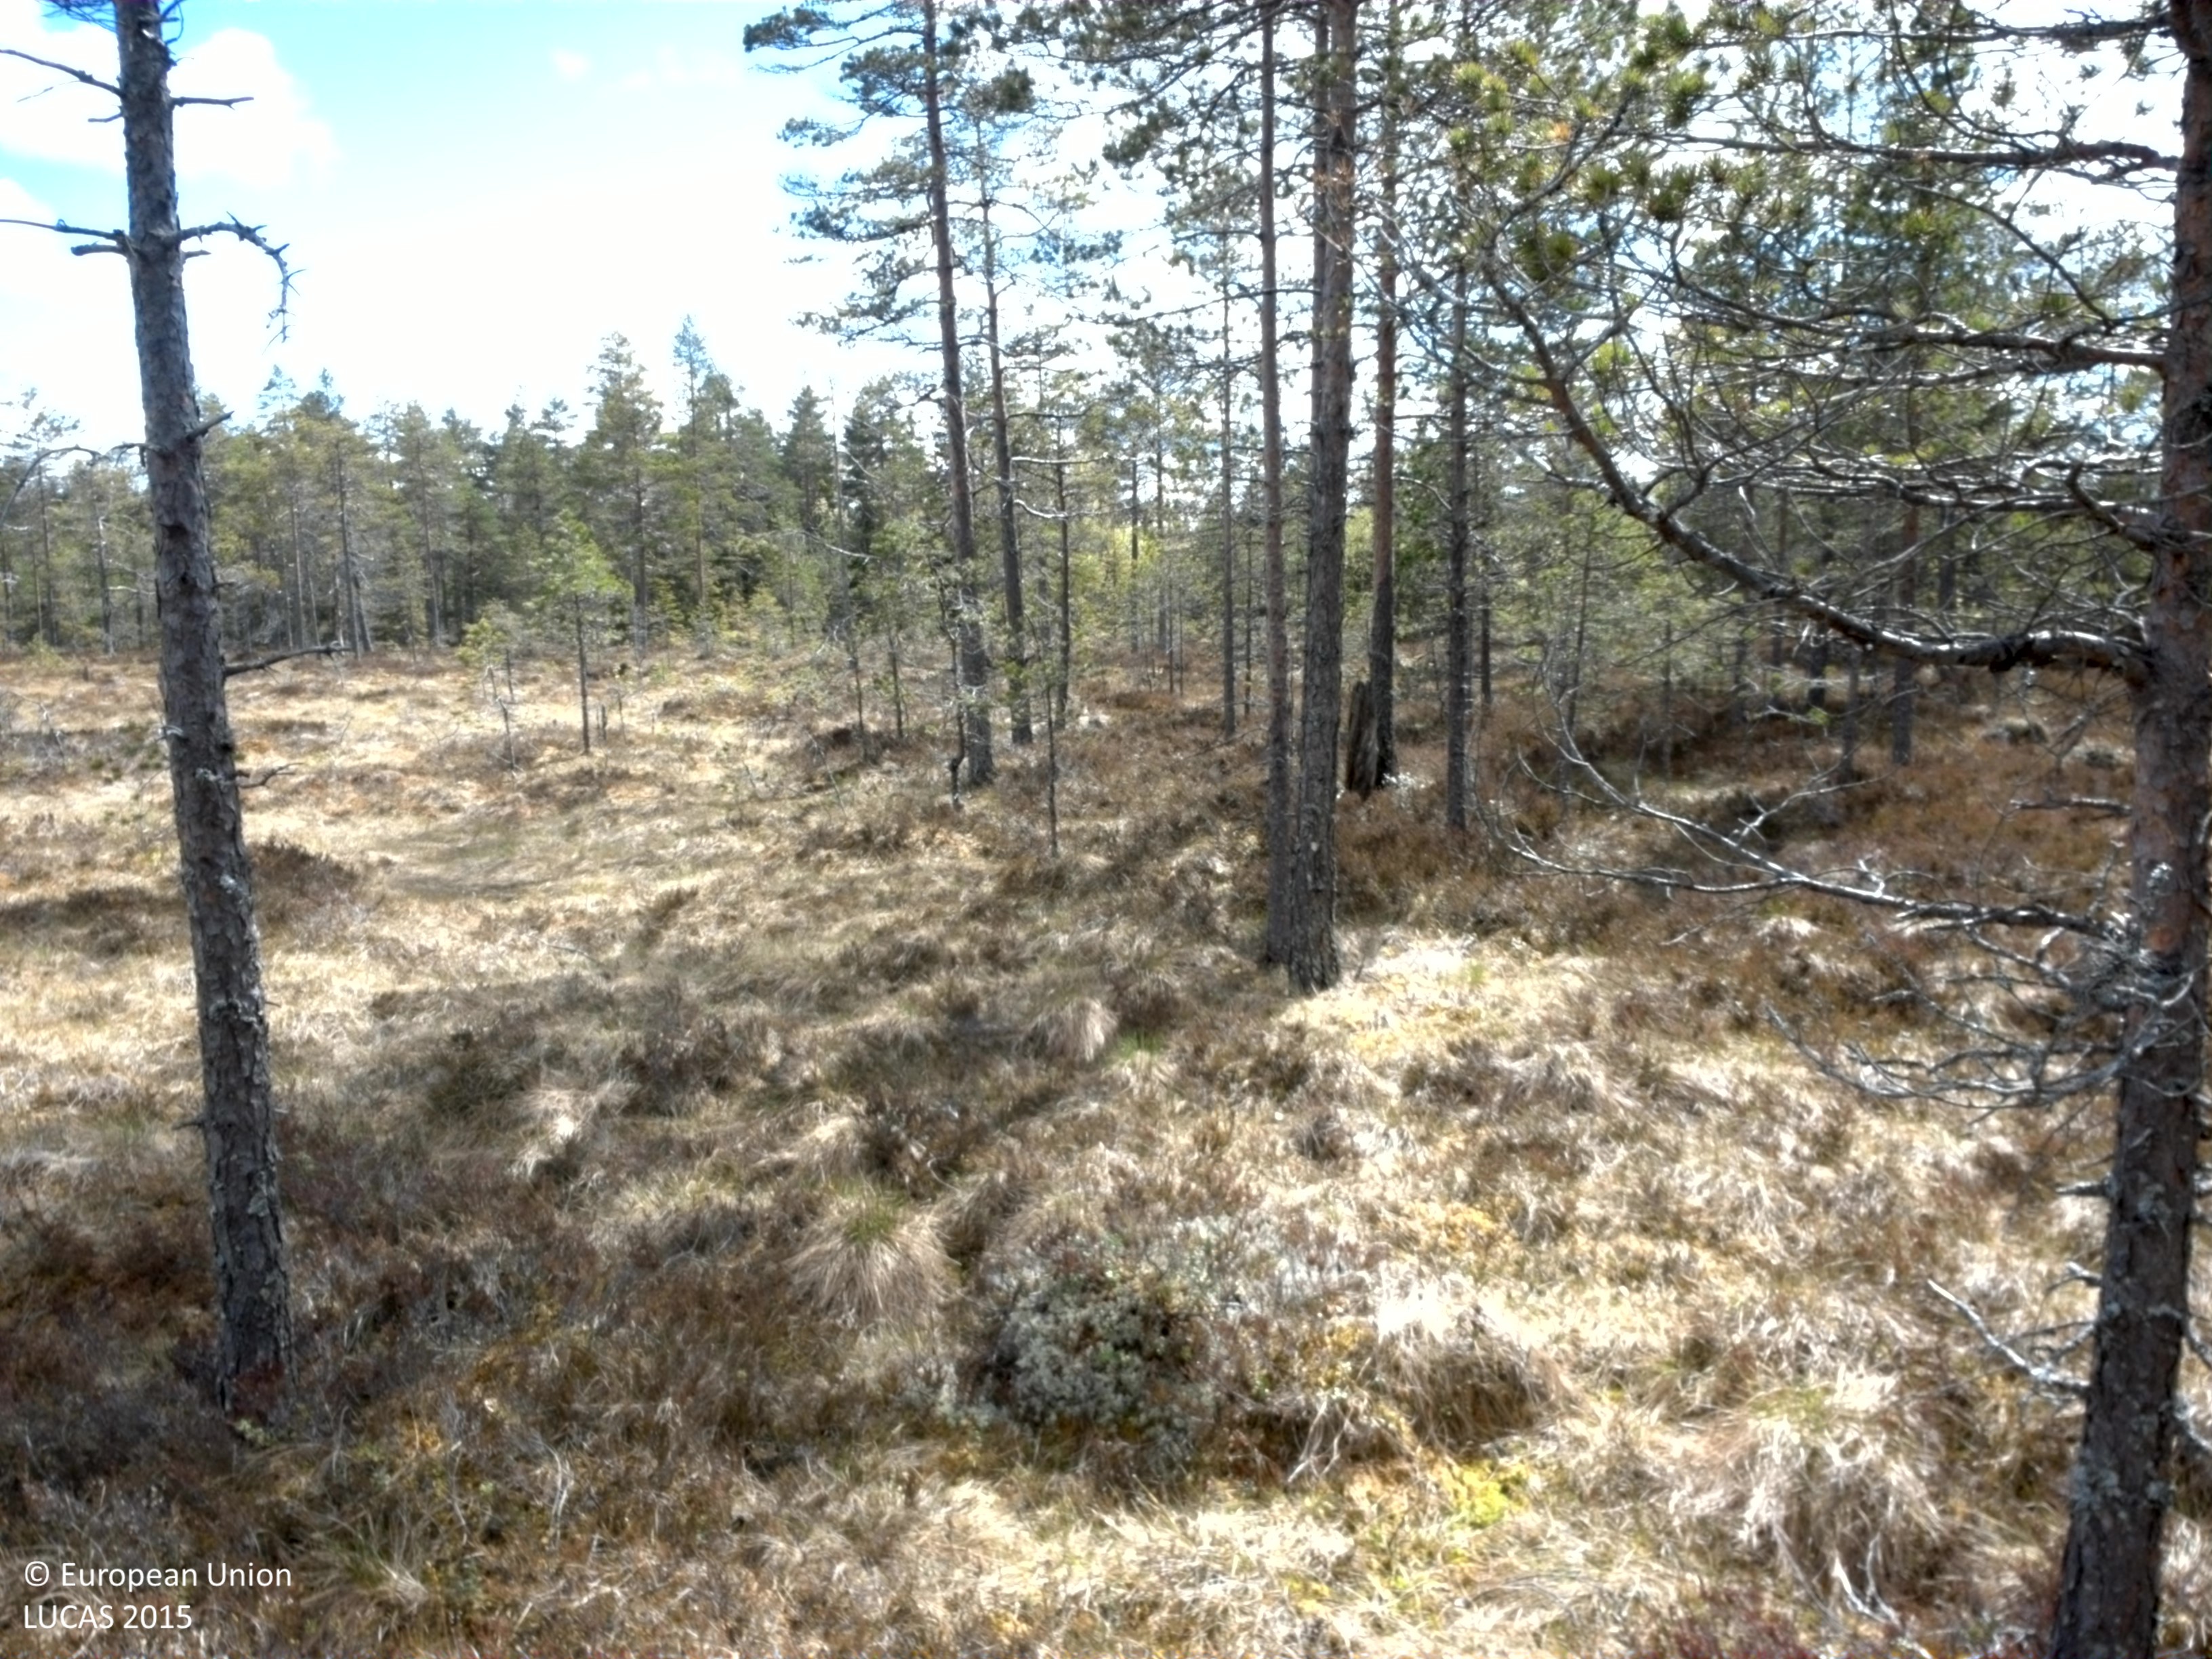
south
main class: Woodland
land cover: Pine dominated coniferous woodland
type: mire and swamp forests
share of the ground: 10 - 25 %
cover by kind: herbaceous plants 45 %, shrubs 40 %, coniferous forest trees 15 %
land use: Semi-natural and natural areas not in use
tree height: > 5 m
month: May
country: SE
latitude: 60.4059
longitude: 13.5659
